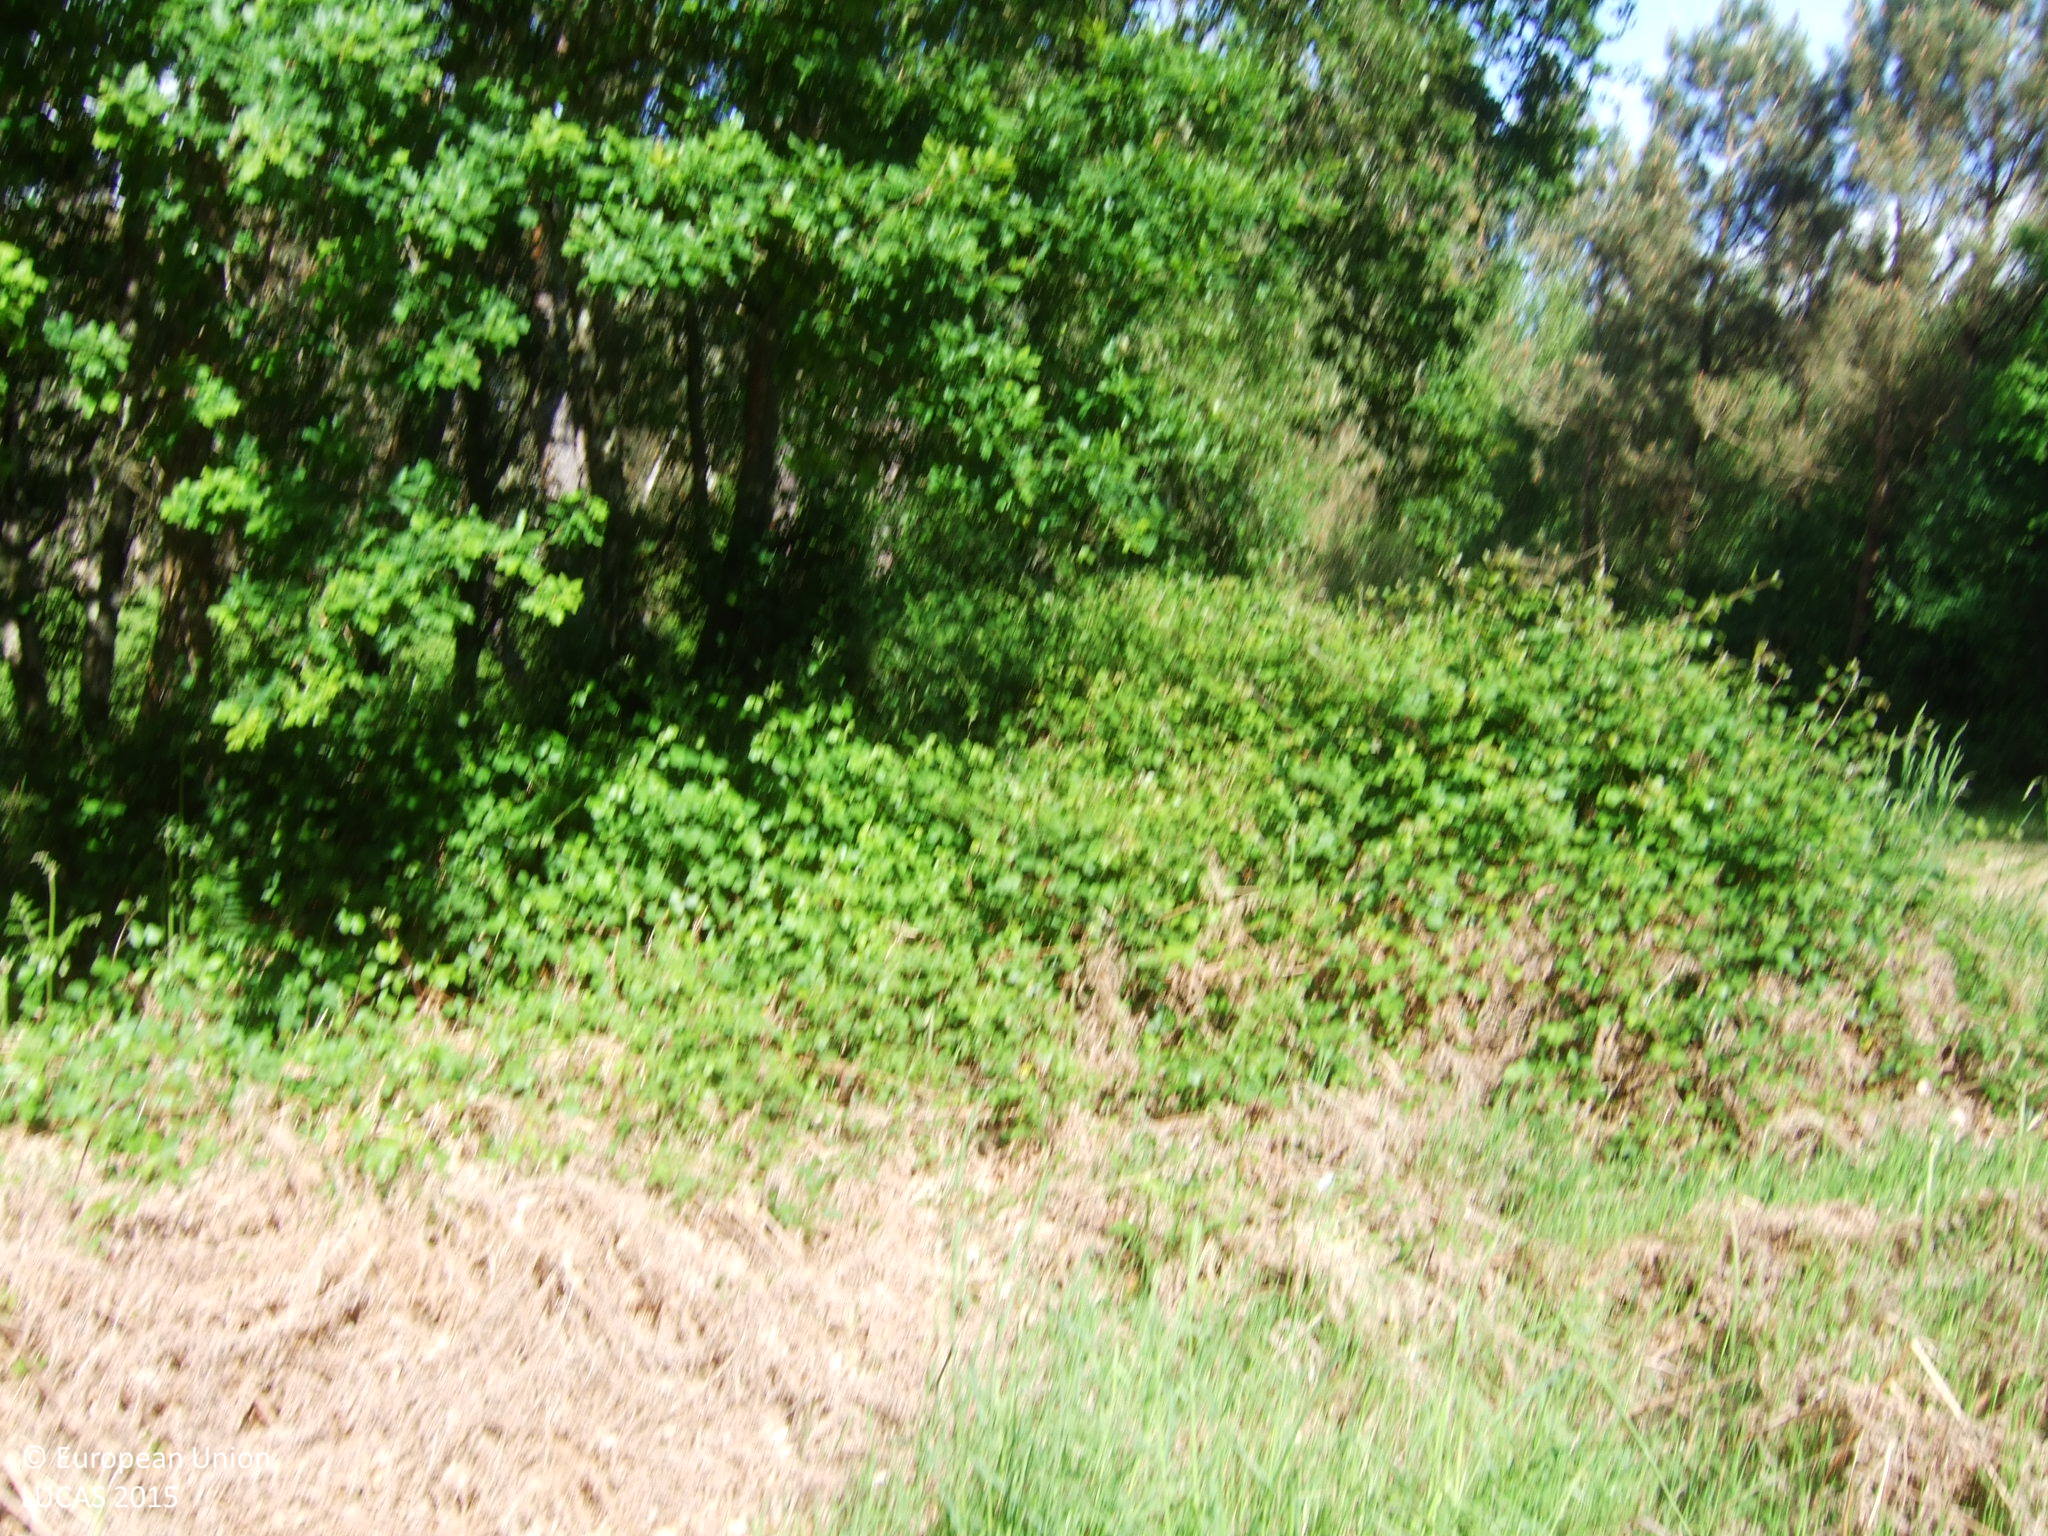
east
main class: Grassland
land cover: Grassland without tree/shrub cover
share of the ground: > 75 %
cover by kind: herbaceous plants 95 %, shrubs 5 %
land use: Agriculture (excluding fallow land and kitchen gardens)
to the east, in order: Grassland without tree/shrub cover; Broadleaved woodland; Pine dominated coniferous woodland; Grassland without tree/shrub cover; Broadleaved woodland
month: May
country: ES
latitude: 43.3334
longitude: -7.7865
